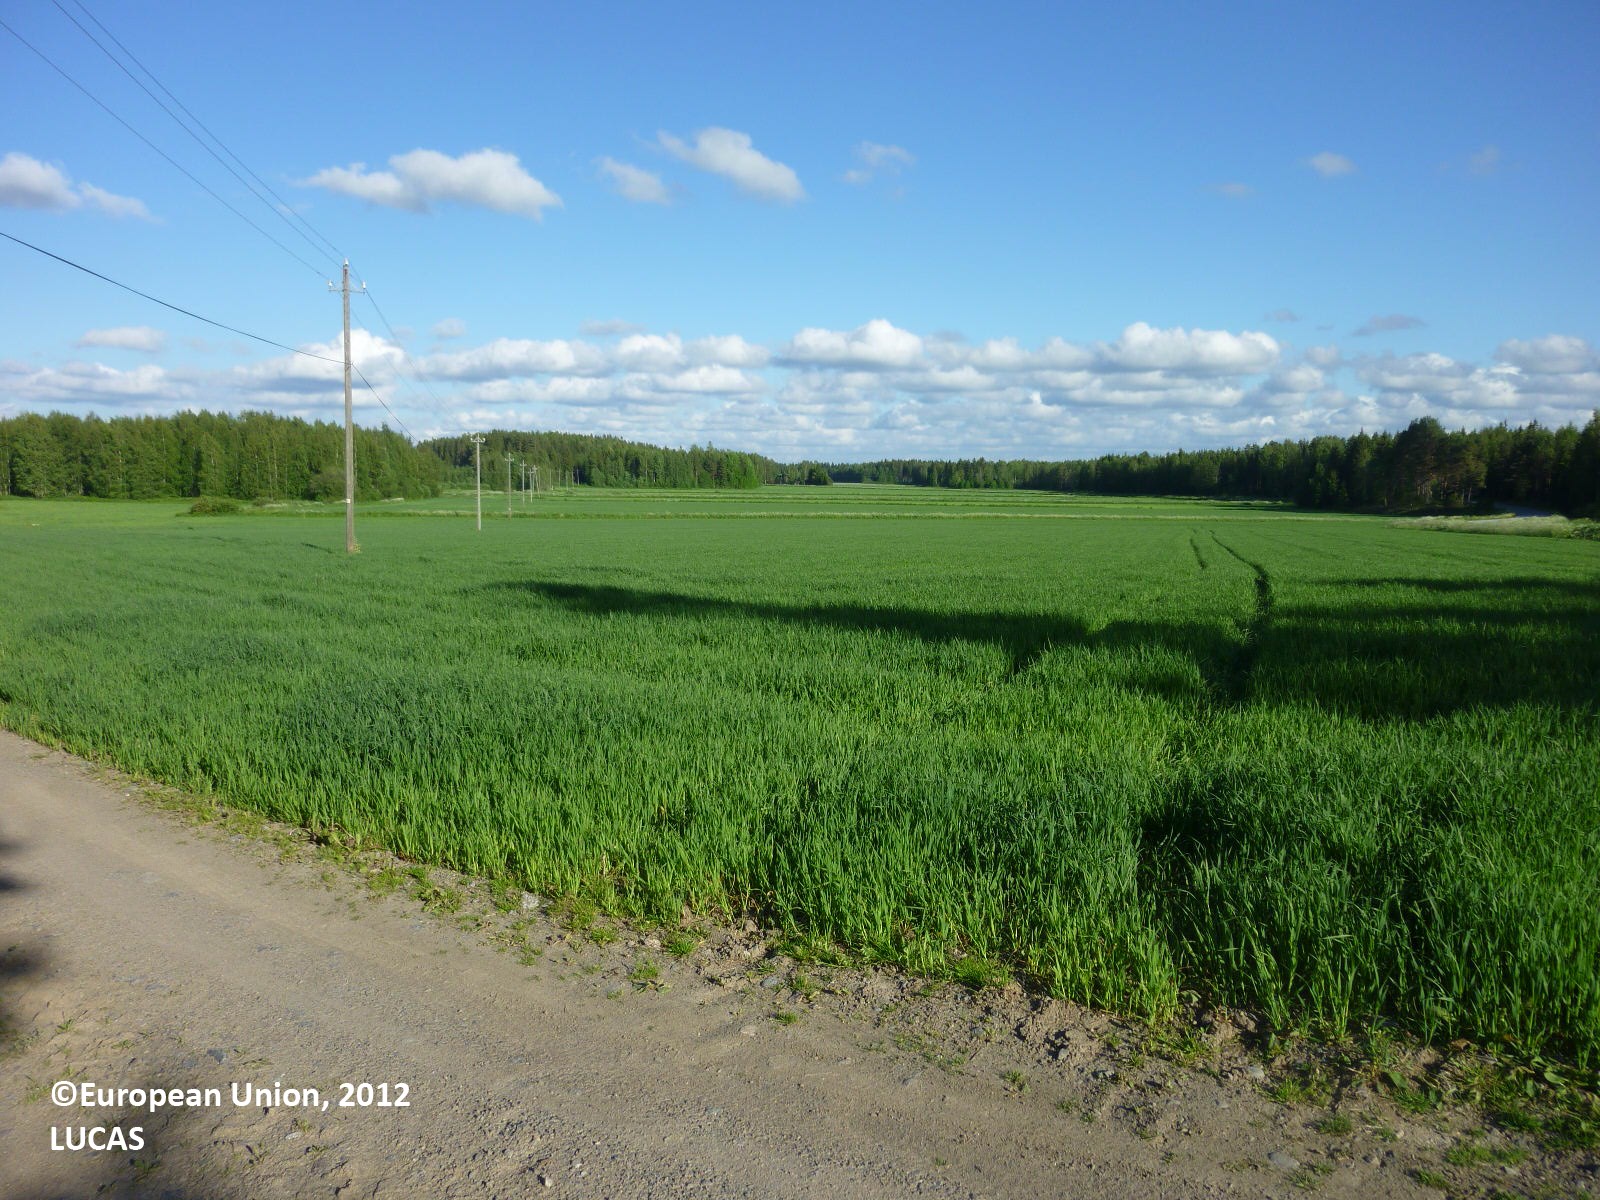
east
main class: Cropland
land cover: Potatoes
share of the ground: 25 - 50 %
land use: Kitchen garden
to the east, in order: Grass margins; Potatoes; Oats; Electric lines; Oats; Paved roads, cycling and walking lanes; Grassland without tree/shrub cover; Abandoned hedges; Inland water bodies; Spruce dominated mixed woodland; Inland water bodies; Spruce dominated mixed woodland; Inland water bodies; Shrubland with sparse tree cover
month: June
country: FI
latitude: 61.5011
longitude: 22.1006
